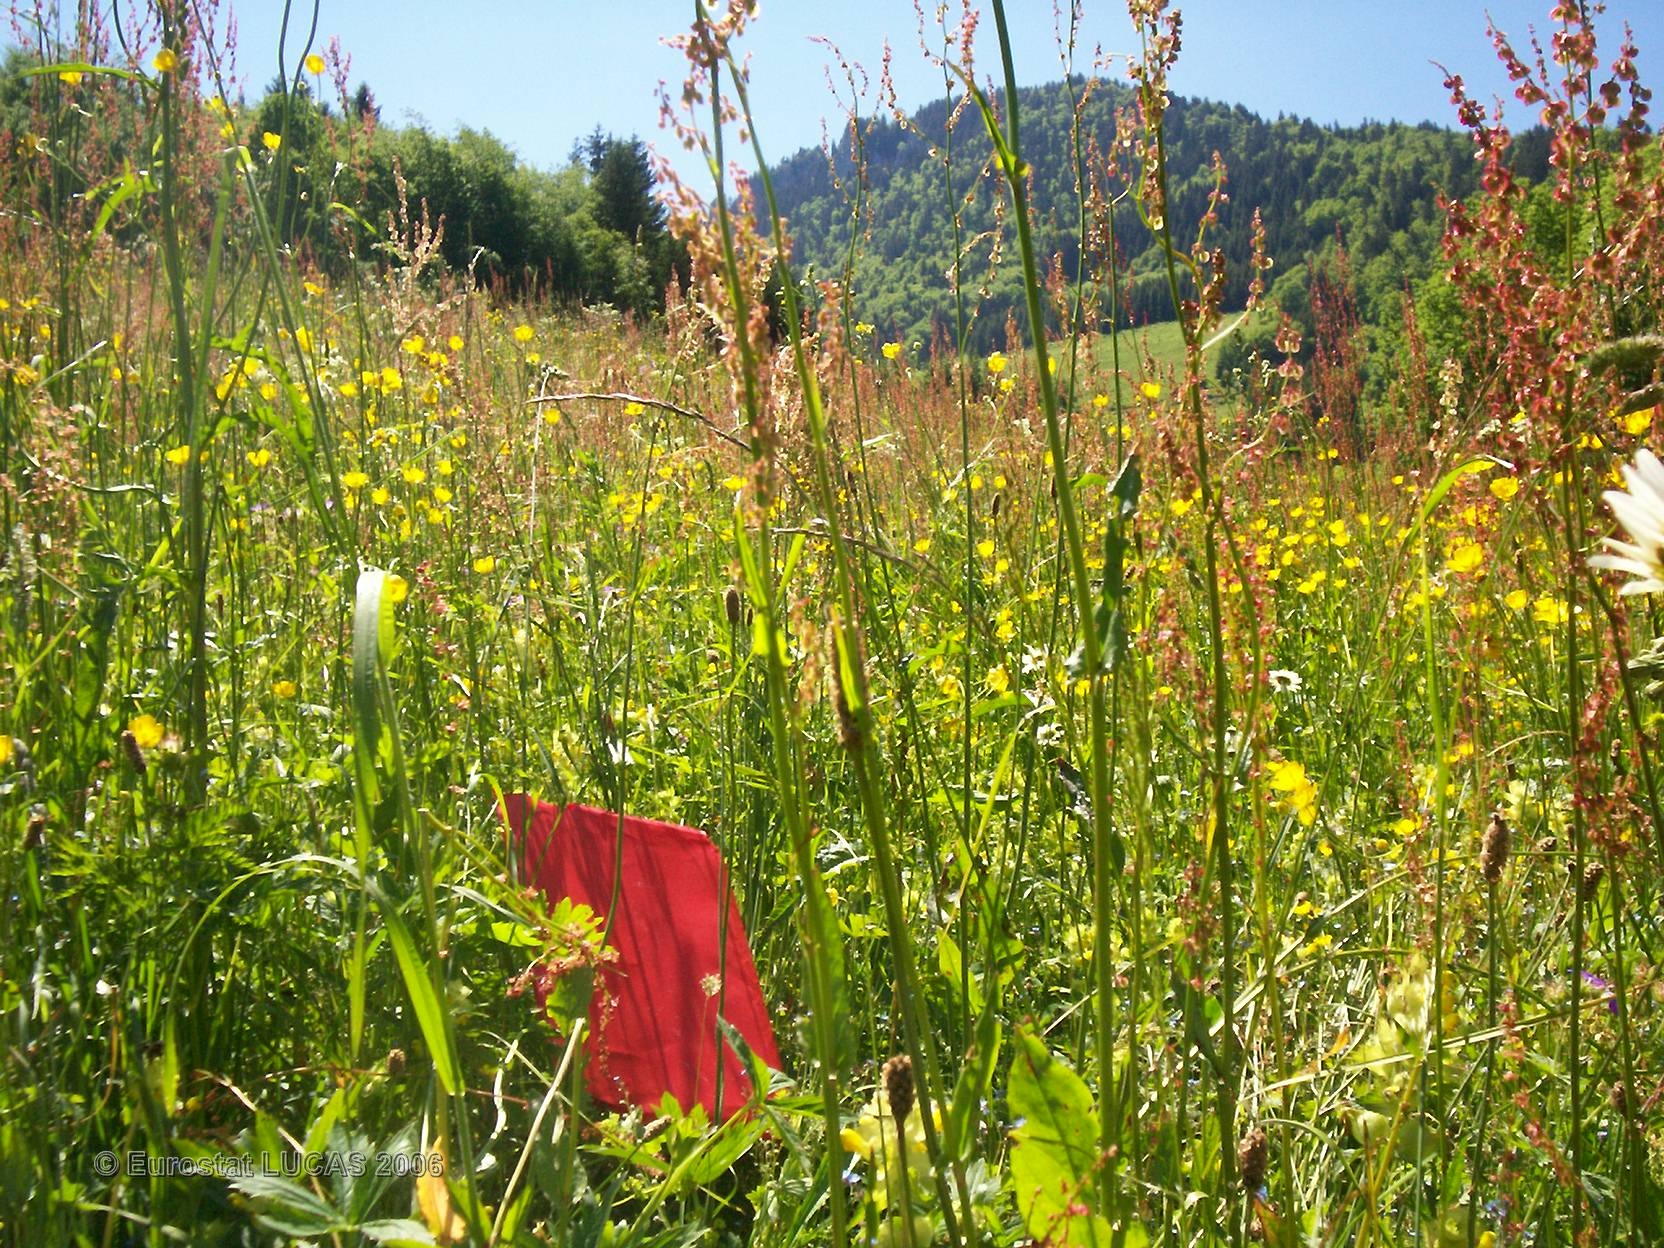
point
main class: Grassland
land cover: Grassland without tree/shrub cover
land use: Agriculture (excluding fallow land and kitchen gardens)
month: June
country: FR
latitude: 46.3173
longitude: 6.6656
